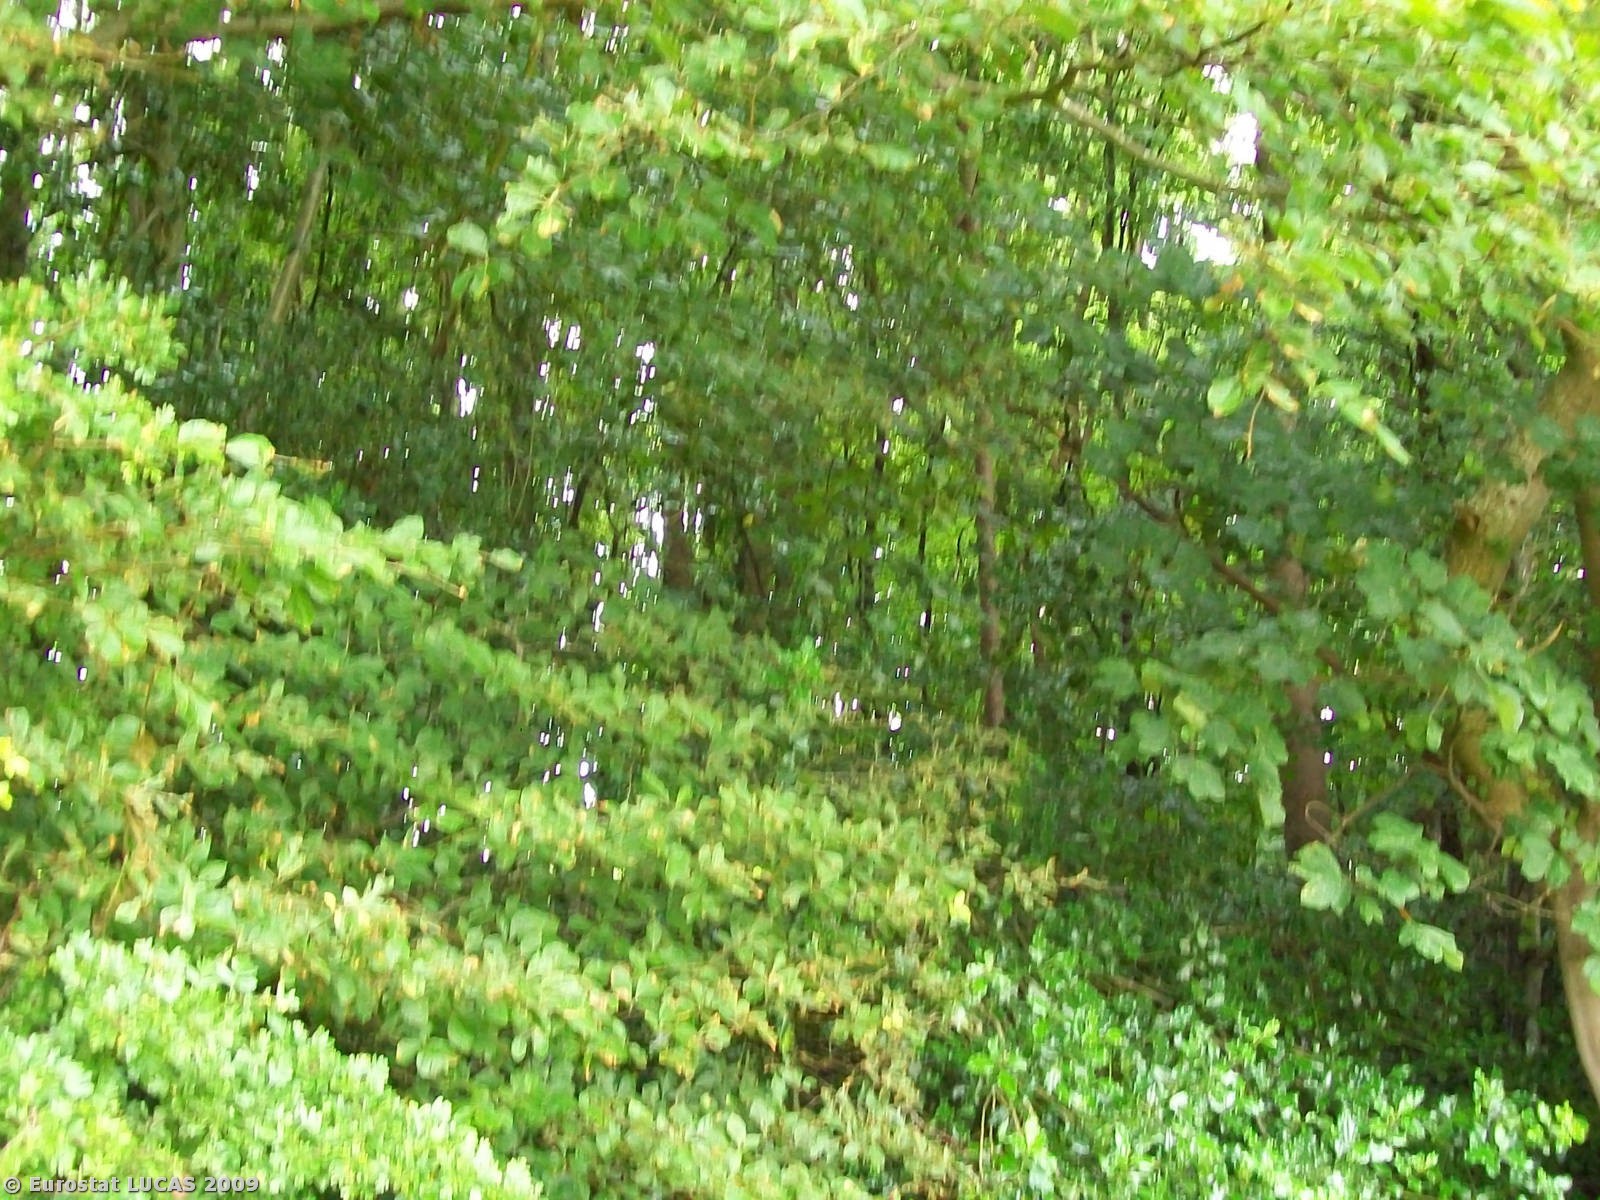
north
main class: Grassland
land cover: Grassland without tree/shrub cover
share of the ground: > 75 %
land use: Agriculture (excluding fallow land and kitchen gardens)
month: July
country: GB
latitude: 55.0034
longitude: -3.2556
